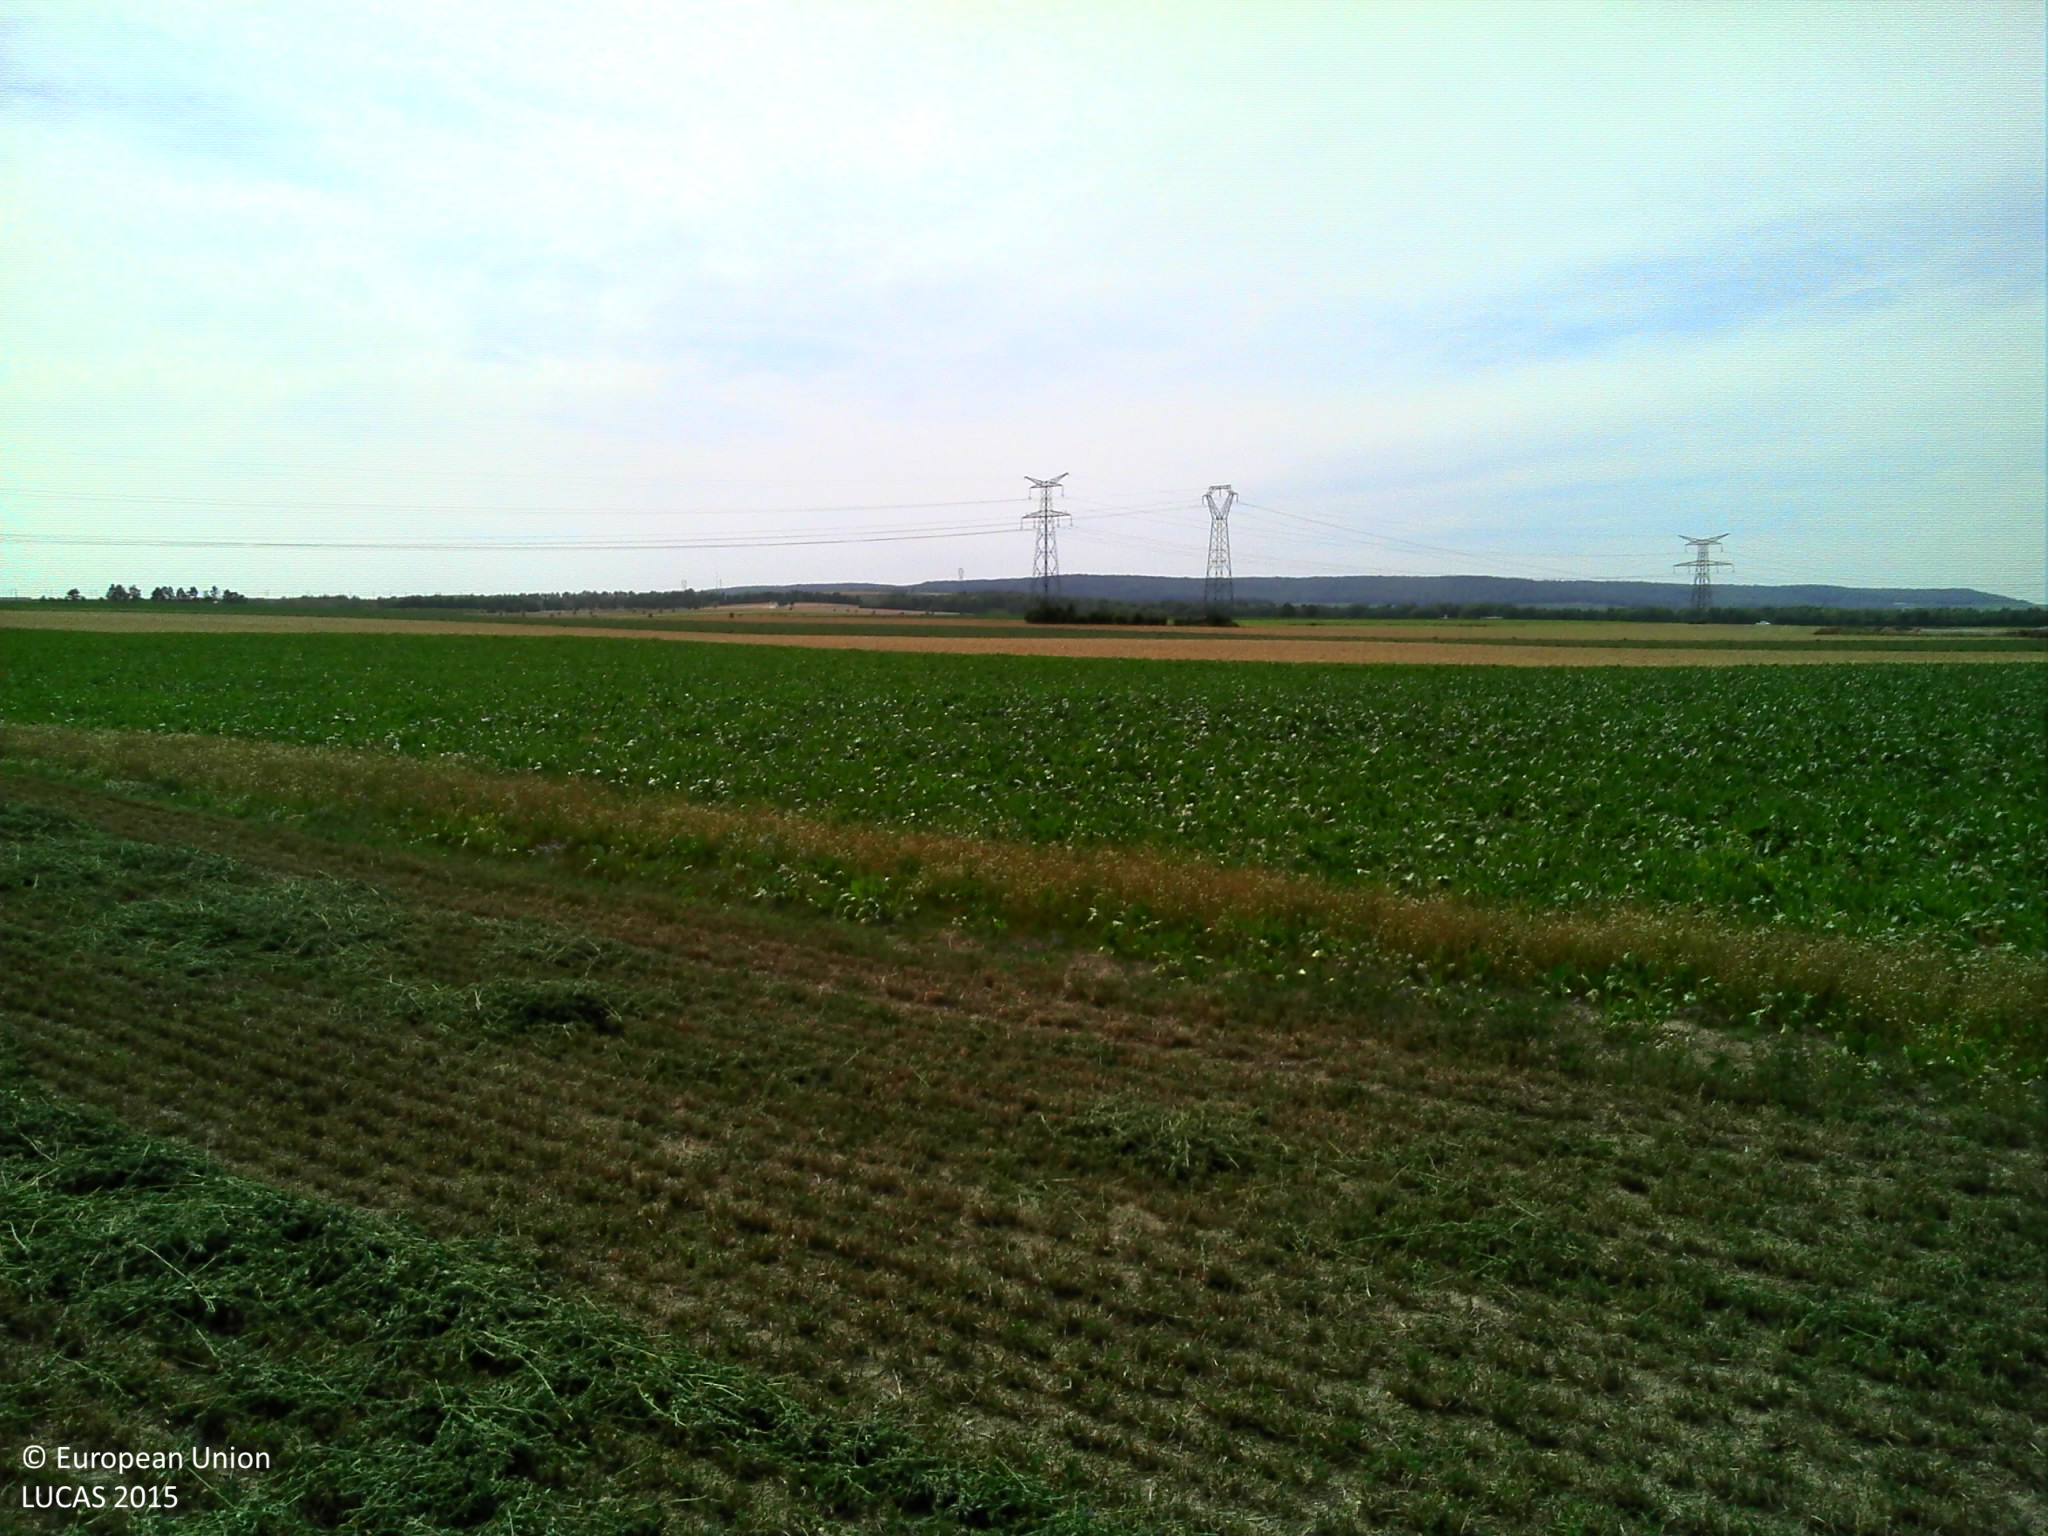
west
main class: Cropland
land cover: Clovers
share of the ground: > 75 %
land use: Agriculture (excluding fallow land and kitchen gardens)
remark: Harvested field
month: August
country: FR
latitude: 49.1213
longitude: 4.2821
